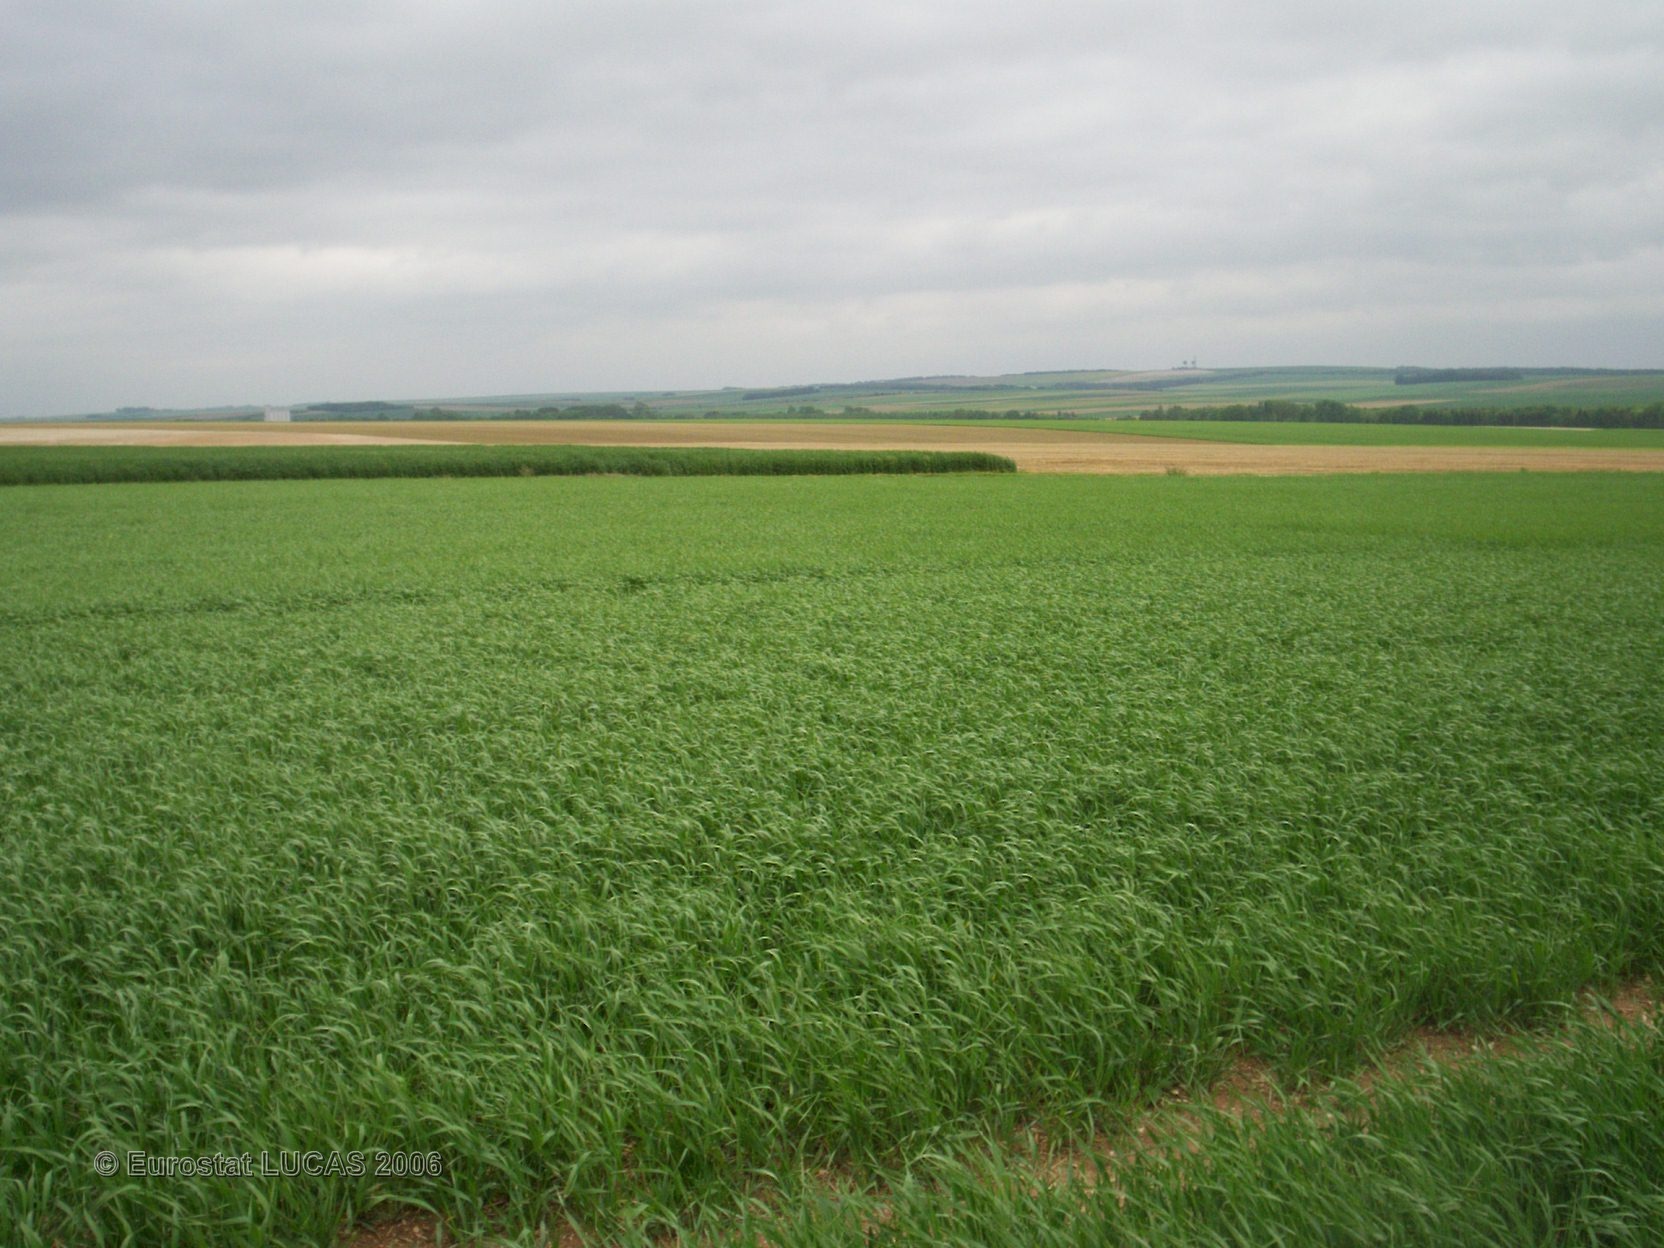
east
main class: Cropland
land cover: Barley
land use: Agriculture (excluding fallow land and kitchen gardens)
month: May
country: FR
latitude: 49.3102
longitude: 4.4531
